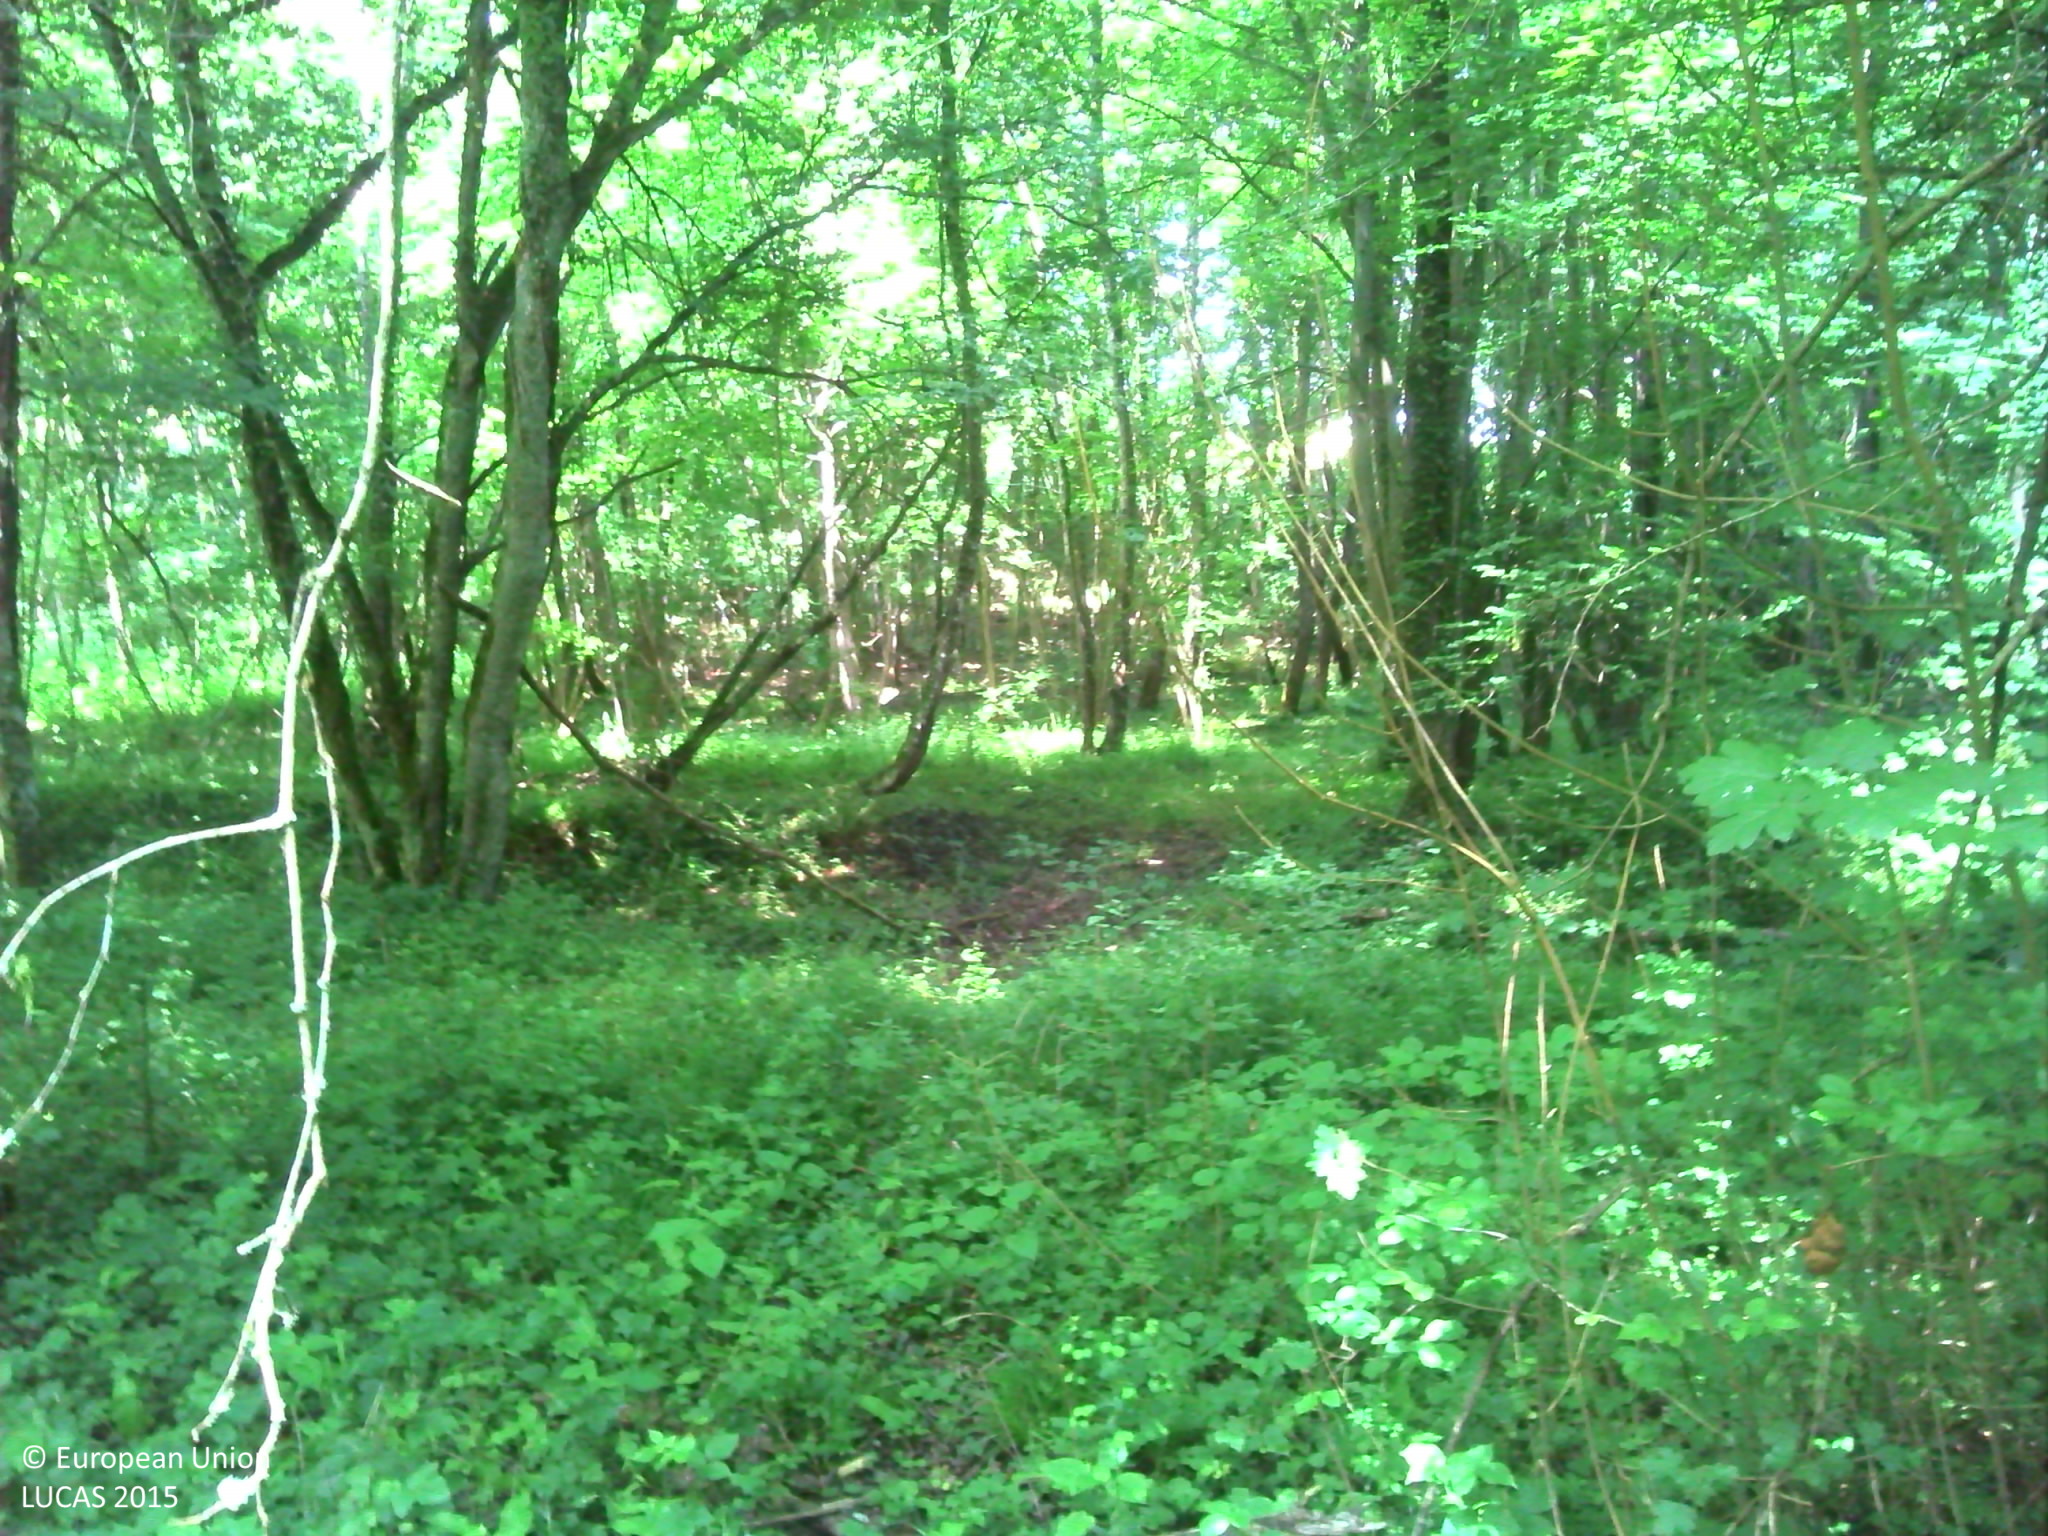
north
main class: Woodland
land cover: Broadleaved woodland
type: mesophytic deciduous forest
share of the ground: > 75 %
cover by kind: broadleaved forest trees 85 %, herbaceous plants 10 %, lichens and mosses 5 %
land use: Forestry
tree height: > 5 m
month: June
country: FR
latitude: 49.2336
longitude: 1.0379
